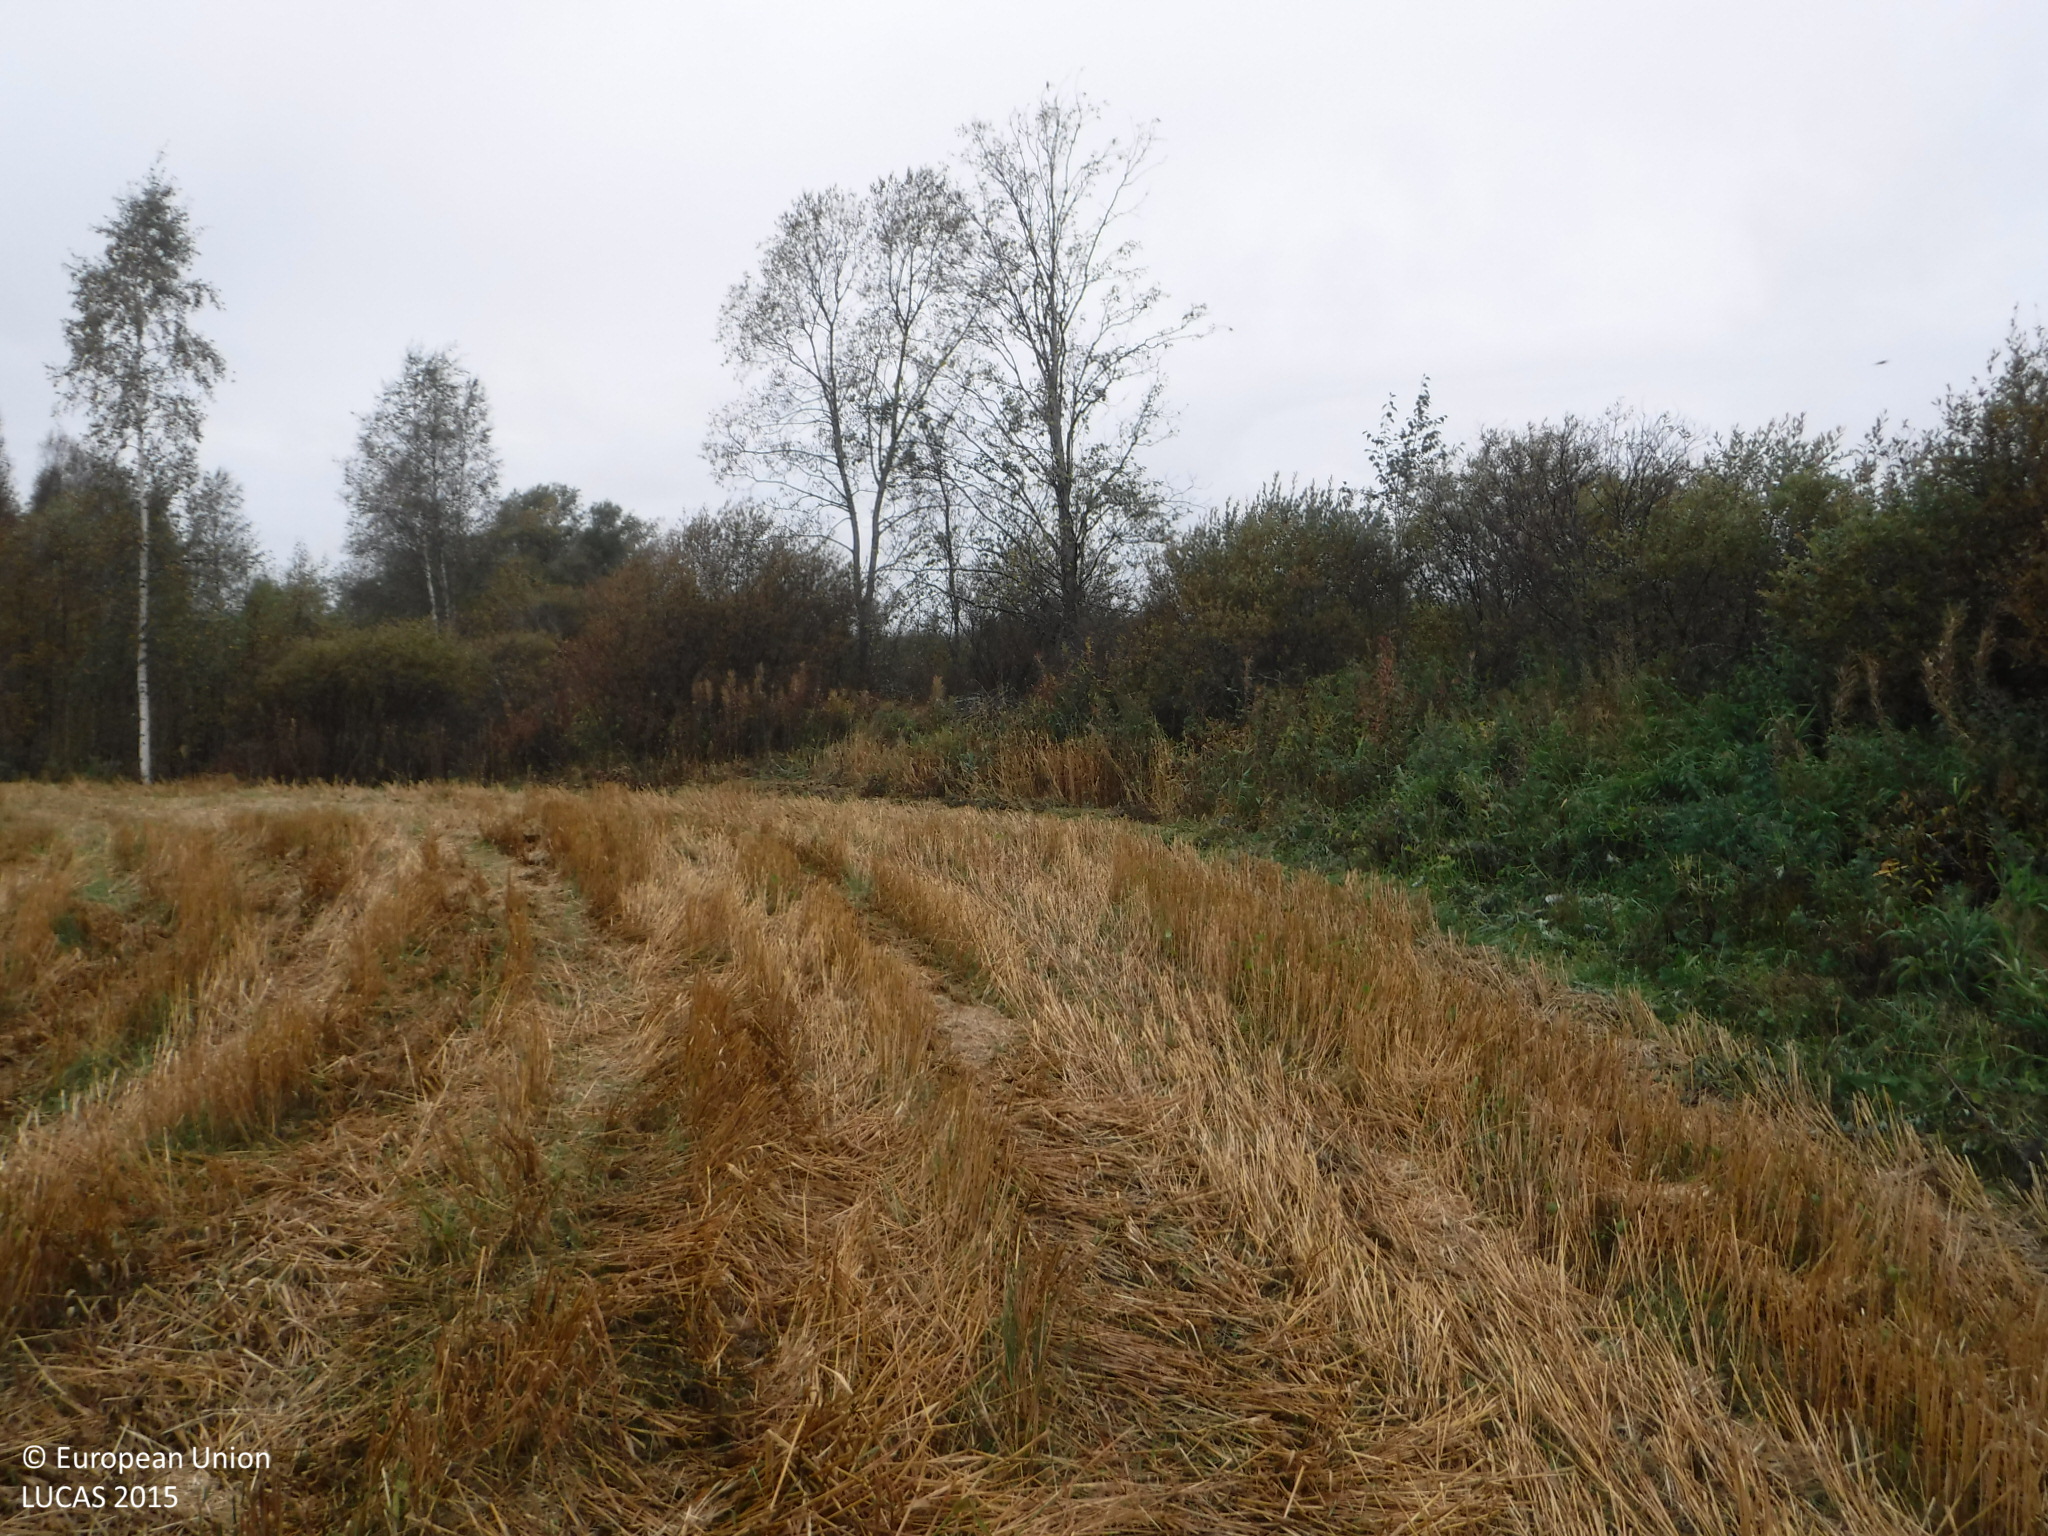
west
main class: Cropland
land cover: Oats
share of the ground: > 75 %
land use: Agriculture (excluding fallow land and kitchen gardens)
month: September
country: FI
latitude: 62.0289
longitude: 22.3463
